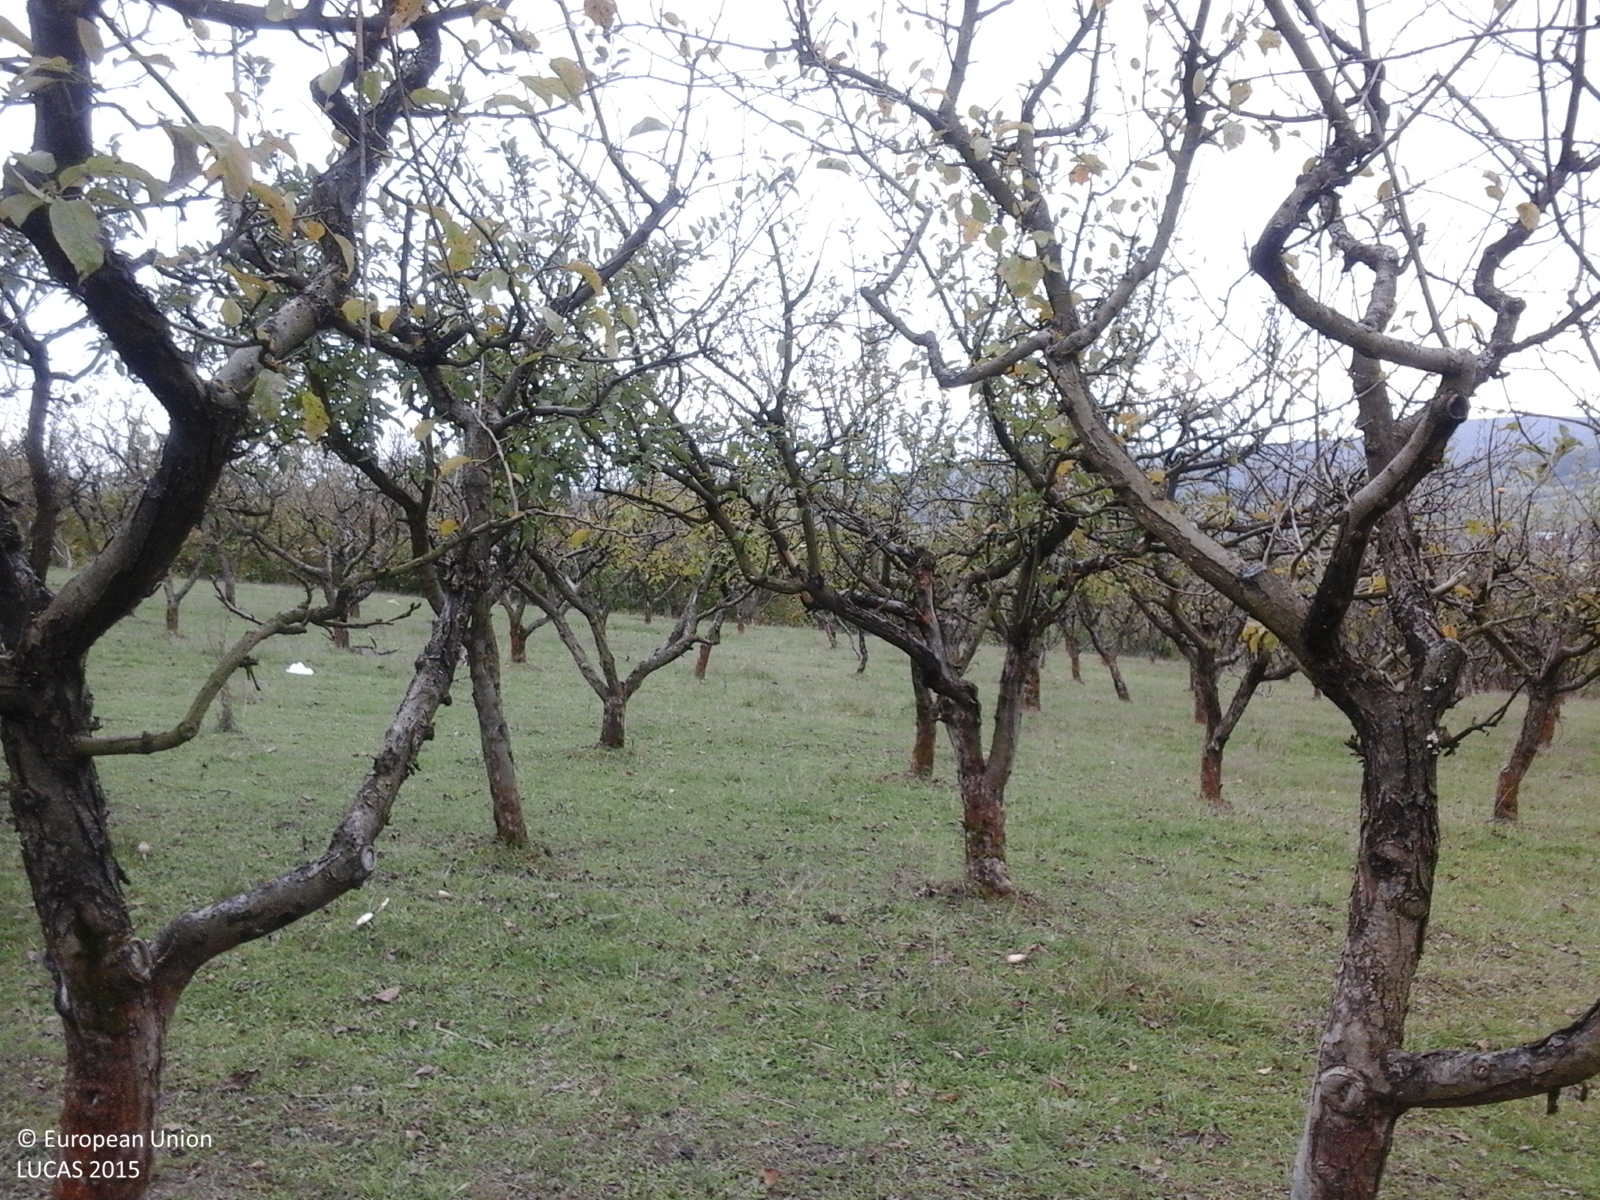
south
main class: Cropland
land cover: Apple fruit
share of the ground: > 75 %
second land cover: Grassland without tree/shrub cover
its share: > 75 %
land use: Agriculture (excluding fallow land and kitchen gardens)
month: October
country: RO
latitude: 45.9149
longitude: 24.8256
